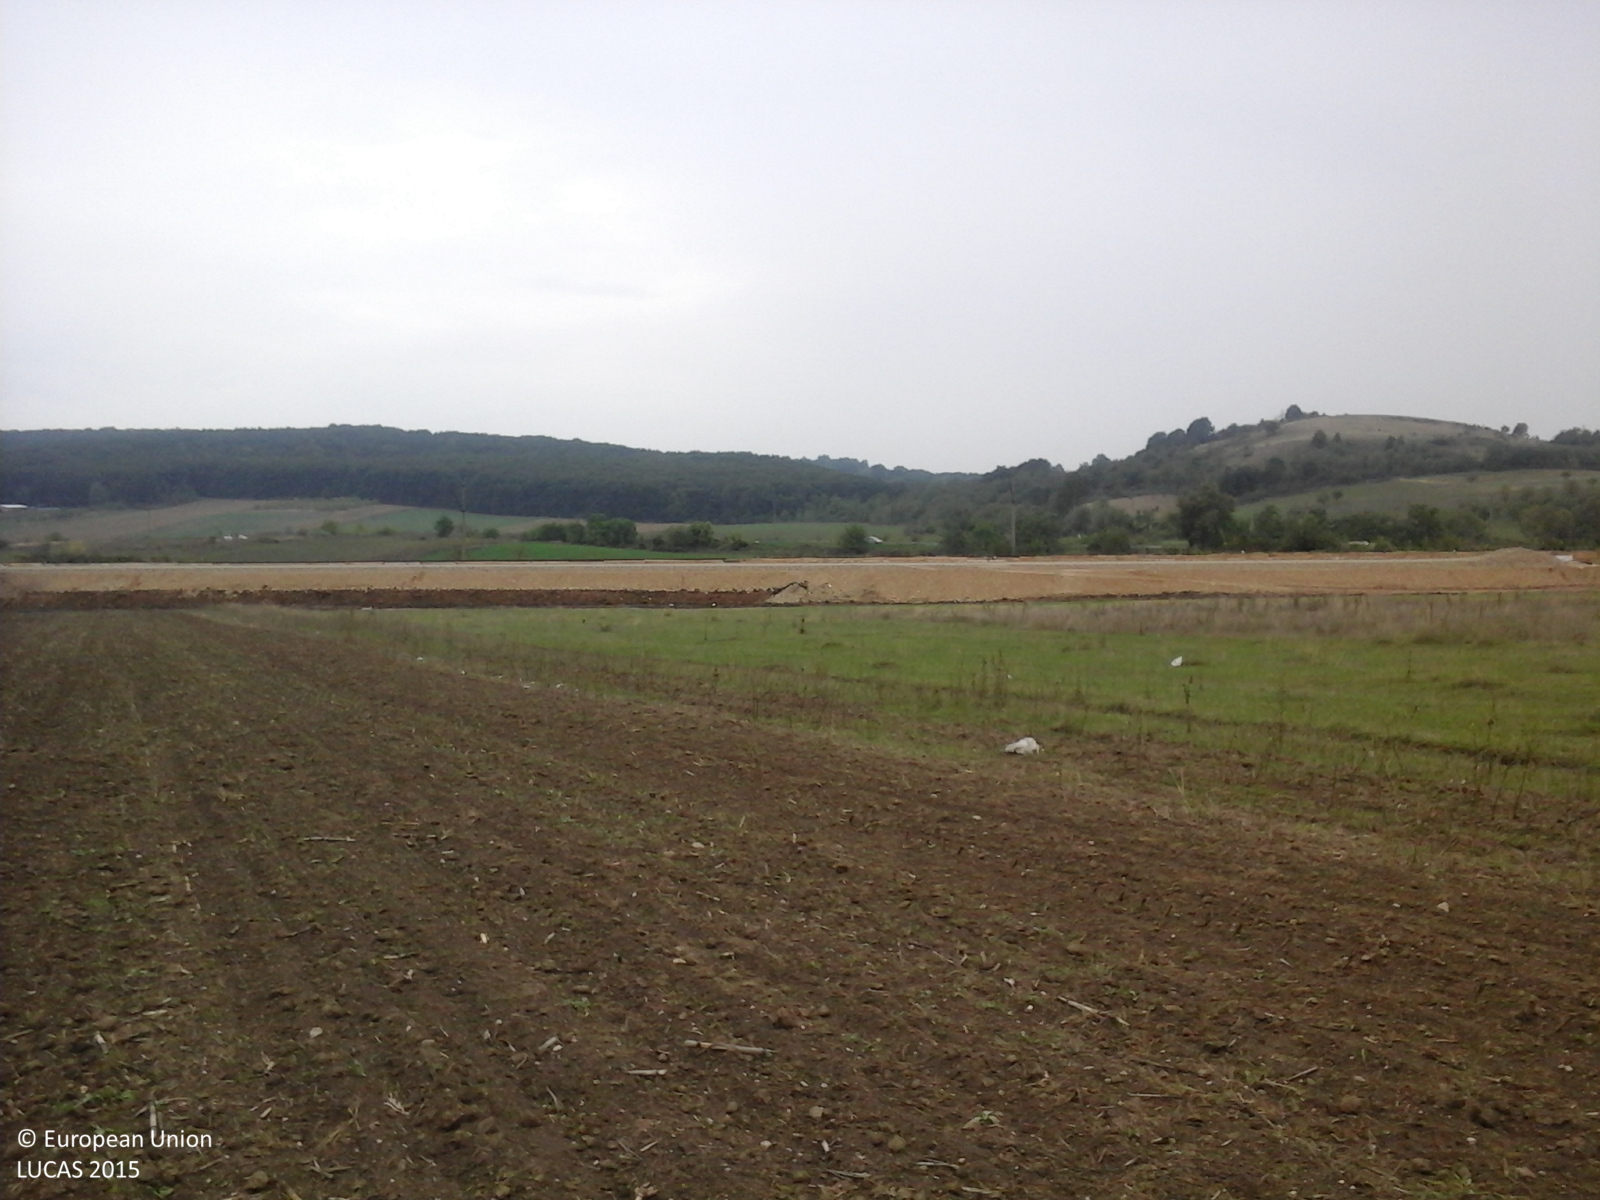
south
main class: Cropland
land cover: Maize
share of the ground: < 10 %
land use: Agriculture (excluding fallow land and kitchen gardens)
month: September
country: RO
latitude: 45.8367
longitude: 23.0725
